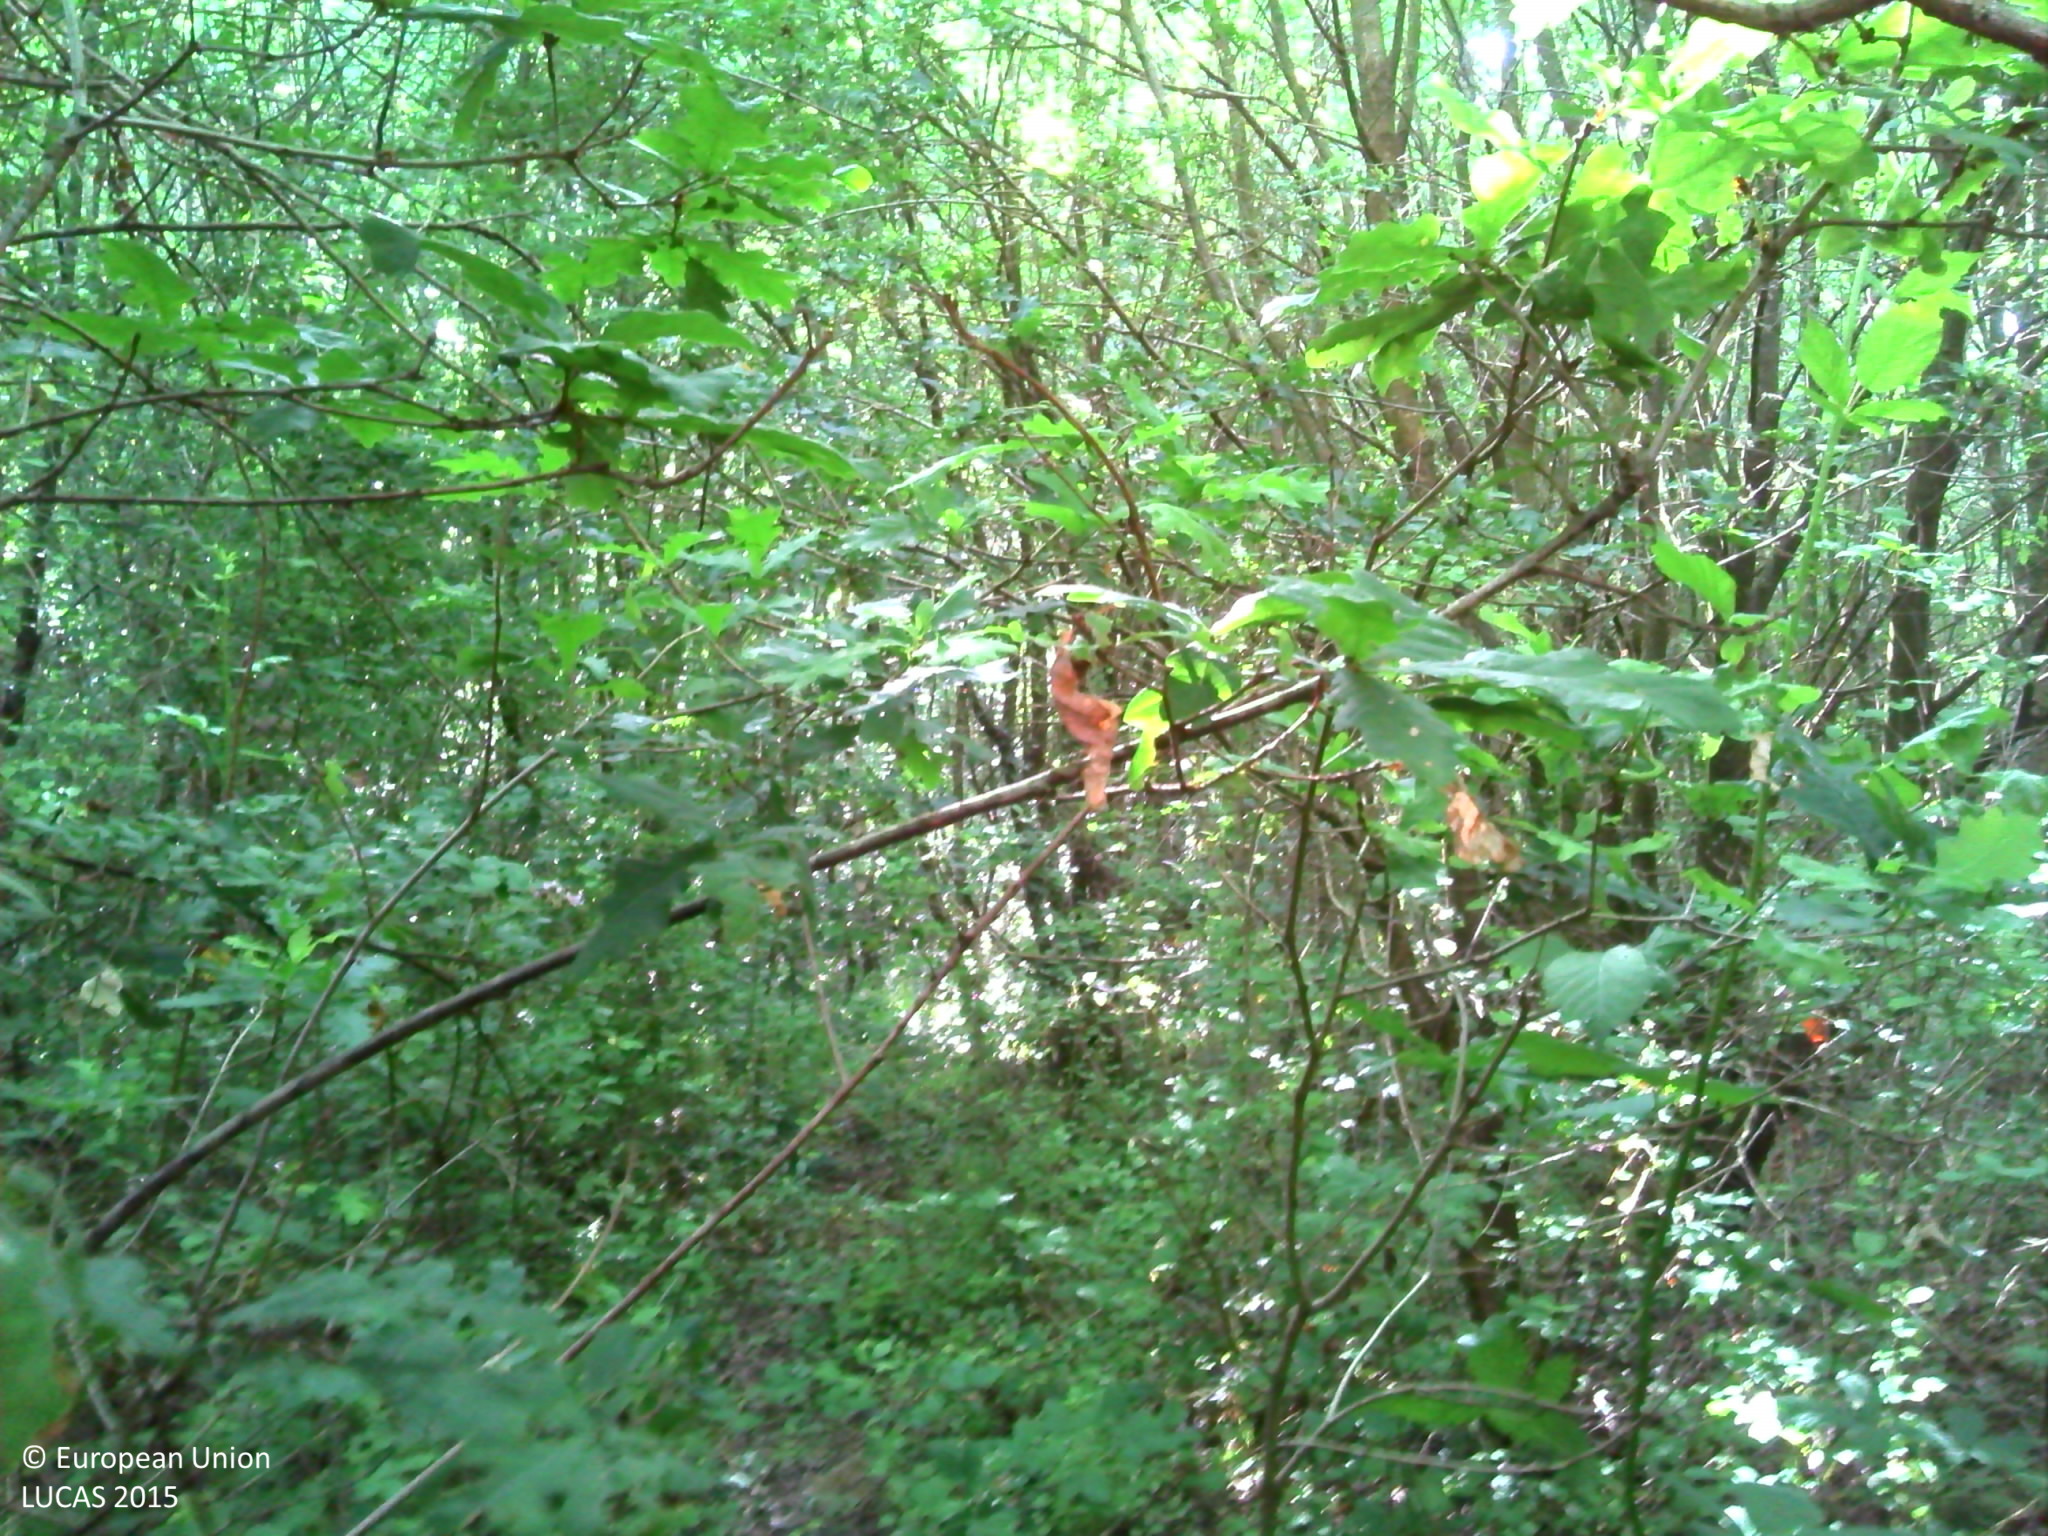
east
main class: Woodland
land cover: Broadleaved woodland
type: mesophytic deciduous forest
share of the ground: > 75 %
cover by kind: broadleaved forest trees 85 %, shrubs 10 %, herbaceous plants 5 %
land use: Semi-natural and natural areas not in use
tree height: > 5 m
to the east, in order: Broadleaved woodland; Tracks; Broadleaved woodland; Shrubland with sparse tree cover; Electric lines; Shrubland with sparse tree cover; Broadleaved woodland
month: June
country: FR
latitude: 47.2711
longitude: -1.5285
